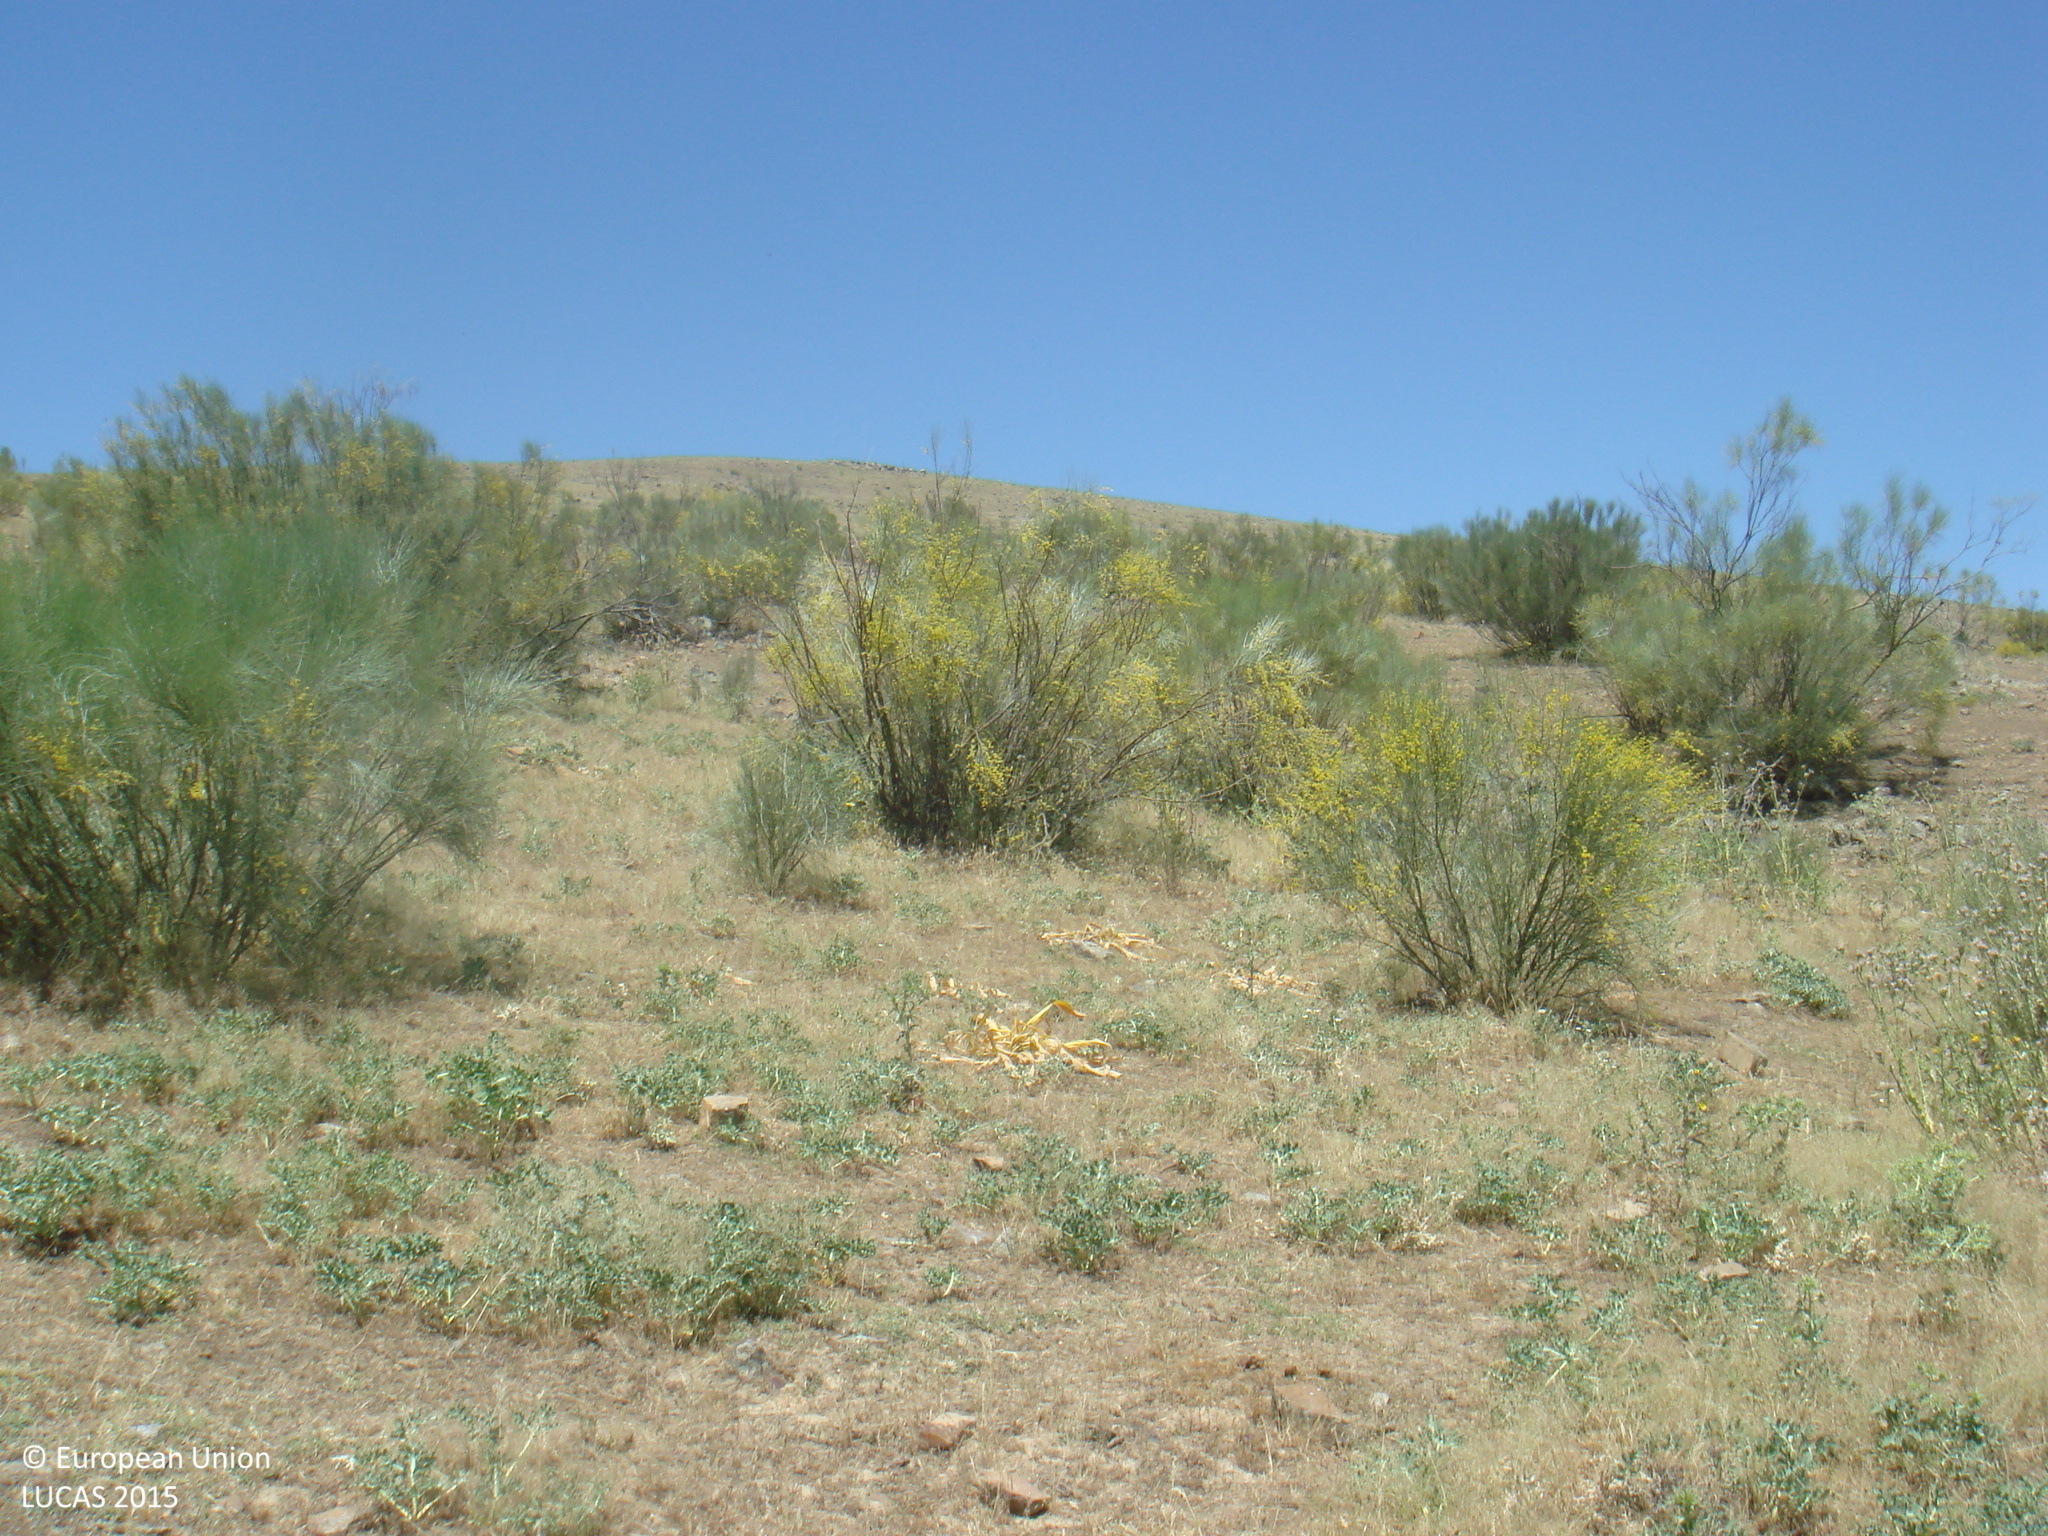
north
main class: Shrubland
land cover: Shrubland without tree cover
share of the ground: 10 - 25 %
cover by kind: herbaceous plants 75 %, shrubs 20 %
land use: Agriculture (excluding fallow land and kitchen gardens)
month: May
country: ES
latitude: 38.7039
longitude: -5.1076
